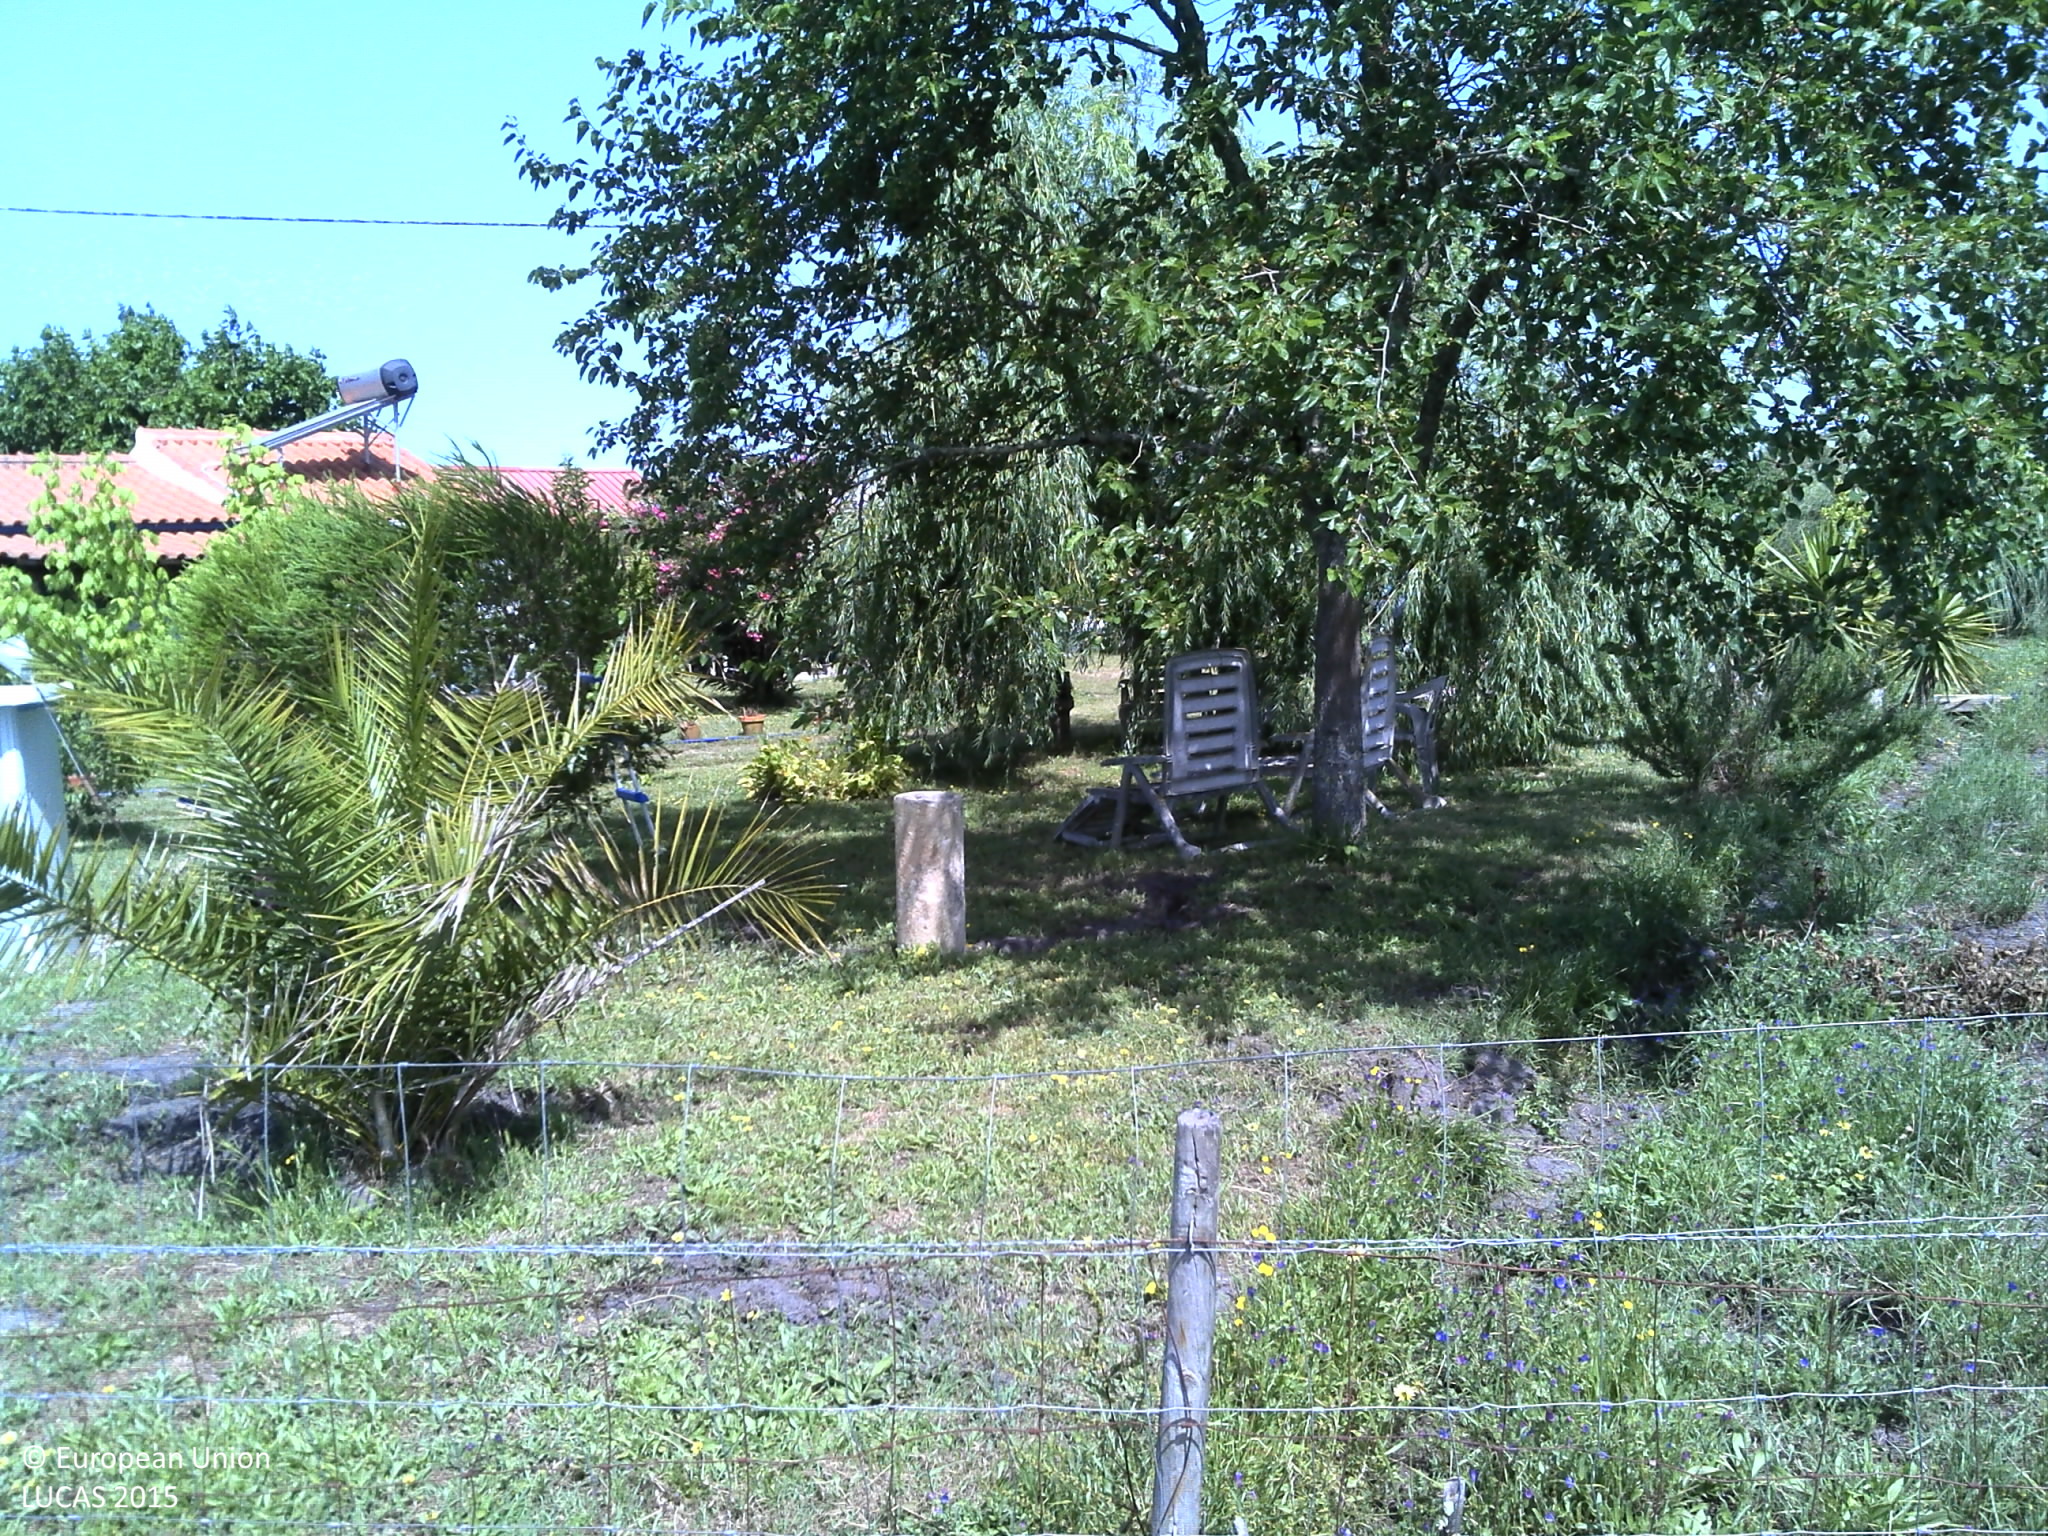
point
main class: Grassland
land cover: Grassland with sparse tree/shrub cover
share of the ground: > 75 %
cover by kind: herbaceous plants 80 %, unconsolidated bare surface 10 %, broadleaved forest trees 5 %
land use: Residential
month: May
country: PT
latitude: 38.2054
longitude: -8.4432
